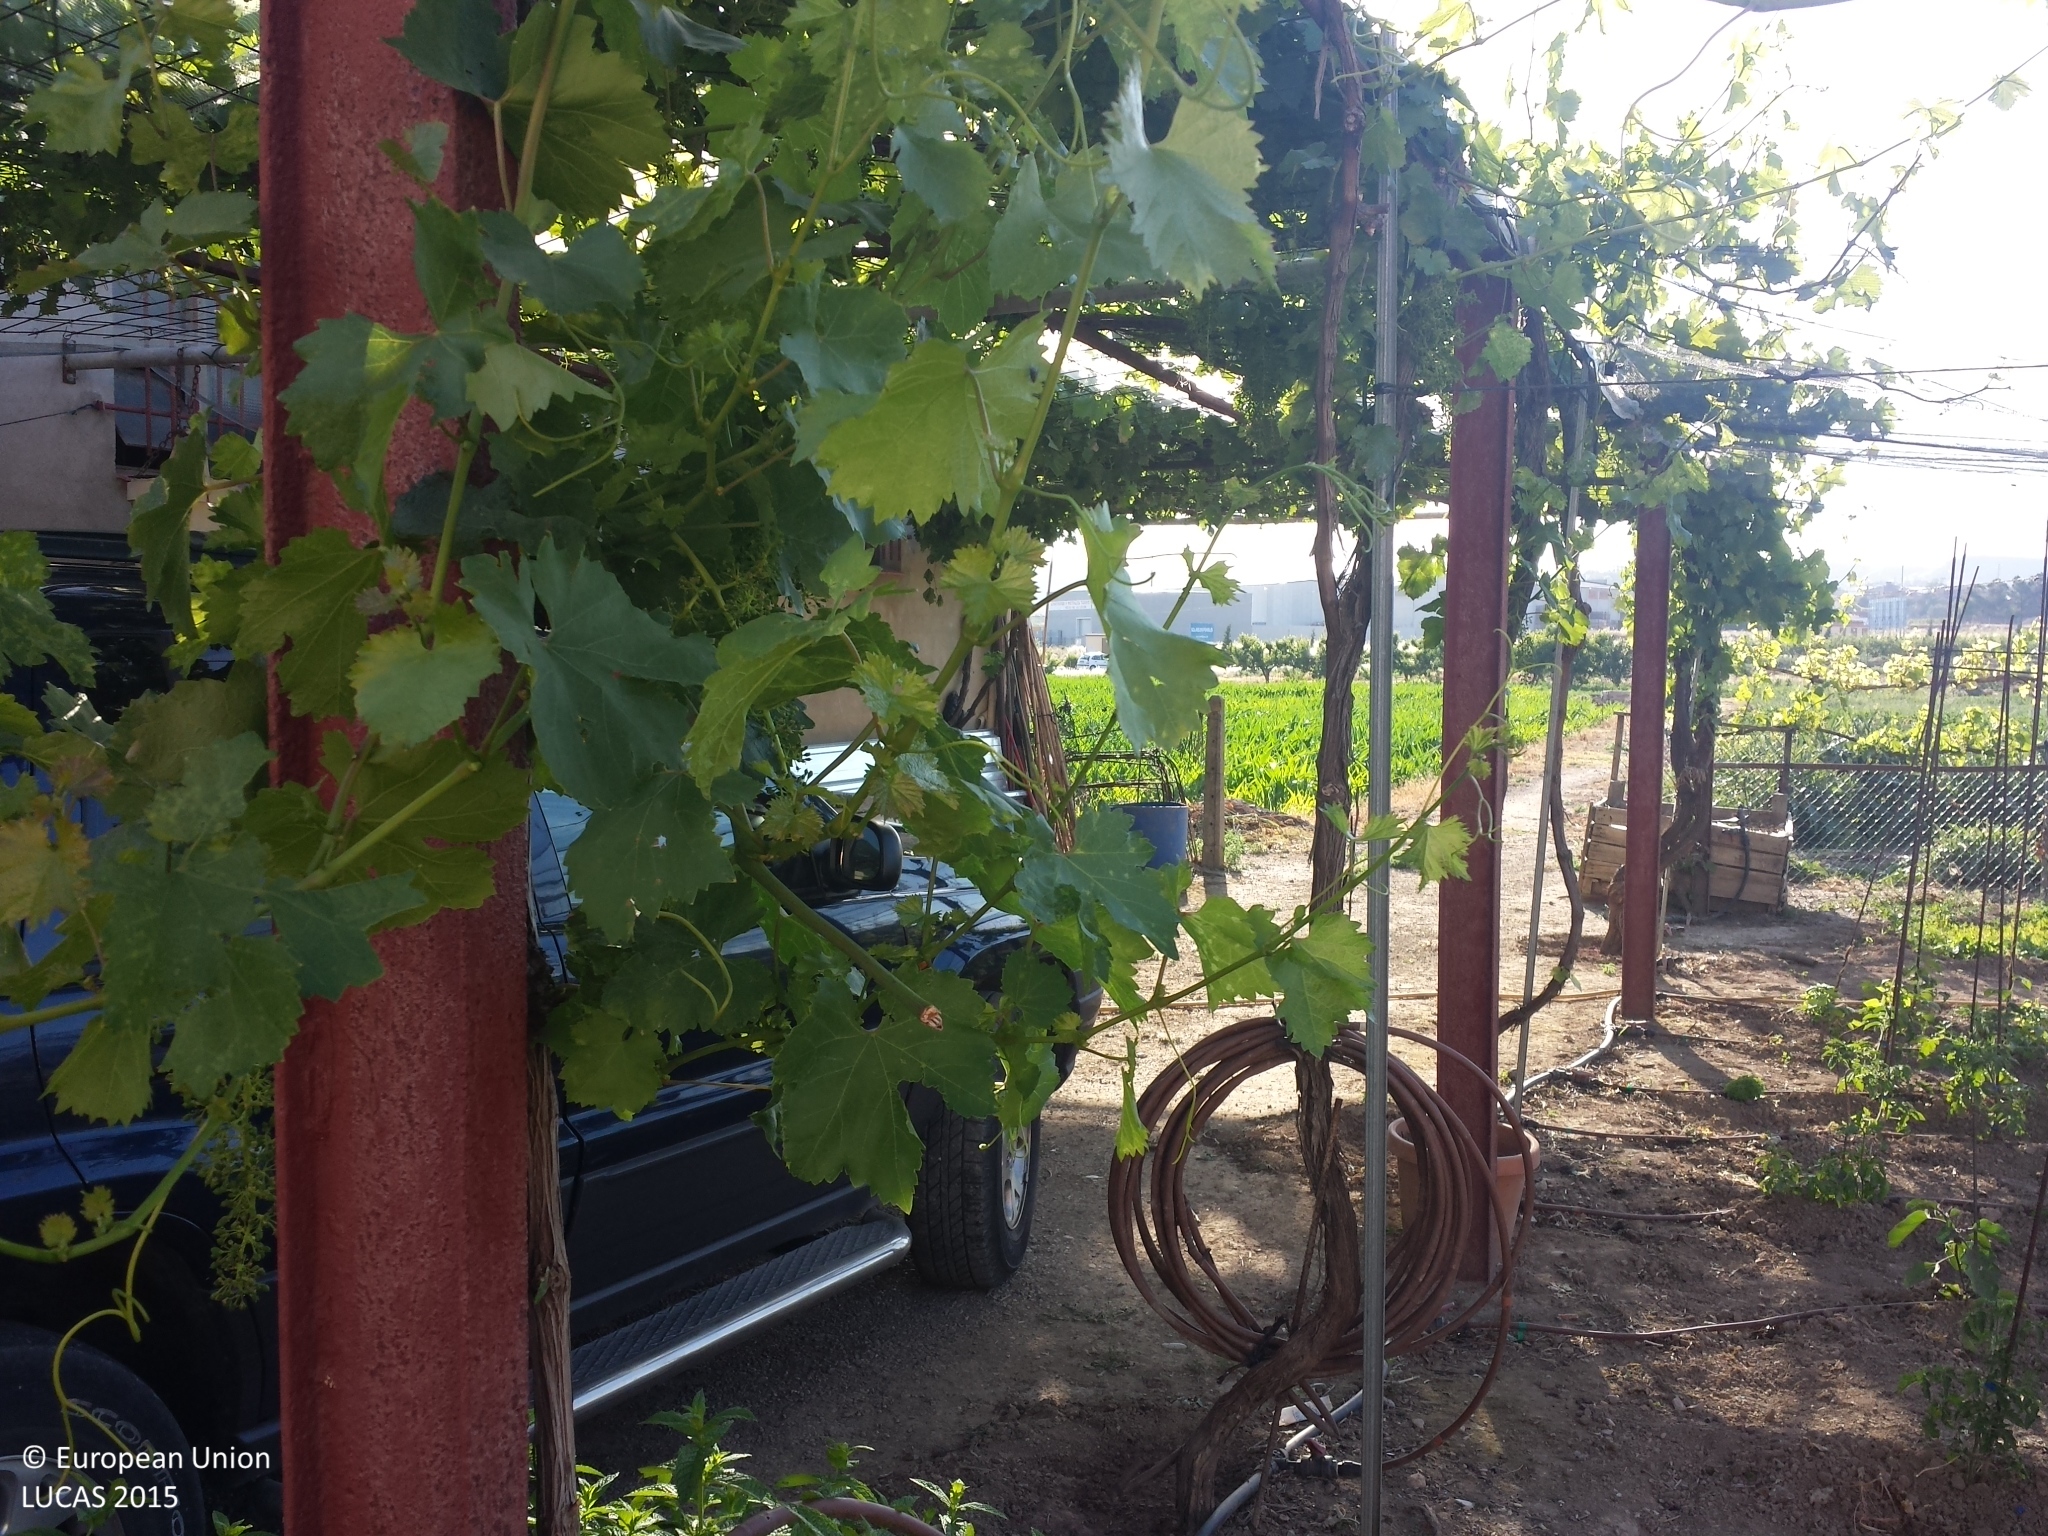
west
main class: Cropland
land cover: Tomatoes
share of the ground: 50 - 75 %
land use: Kitchen garden
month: May
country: ES
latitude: 41.6714
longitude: 0.6064
